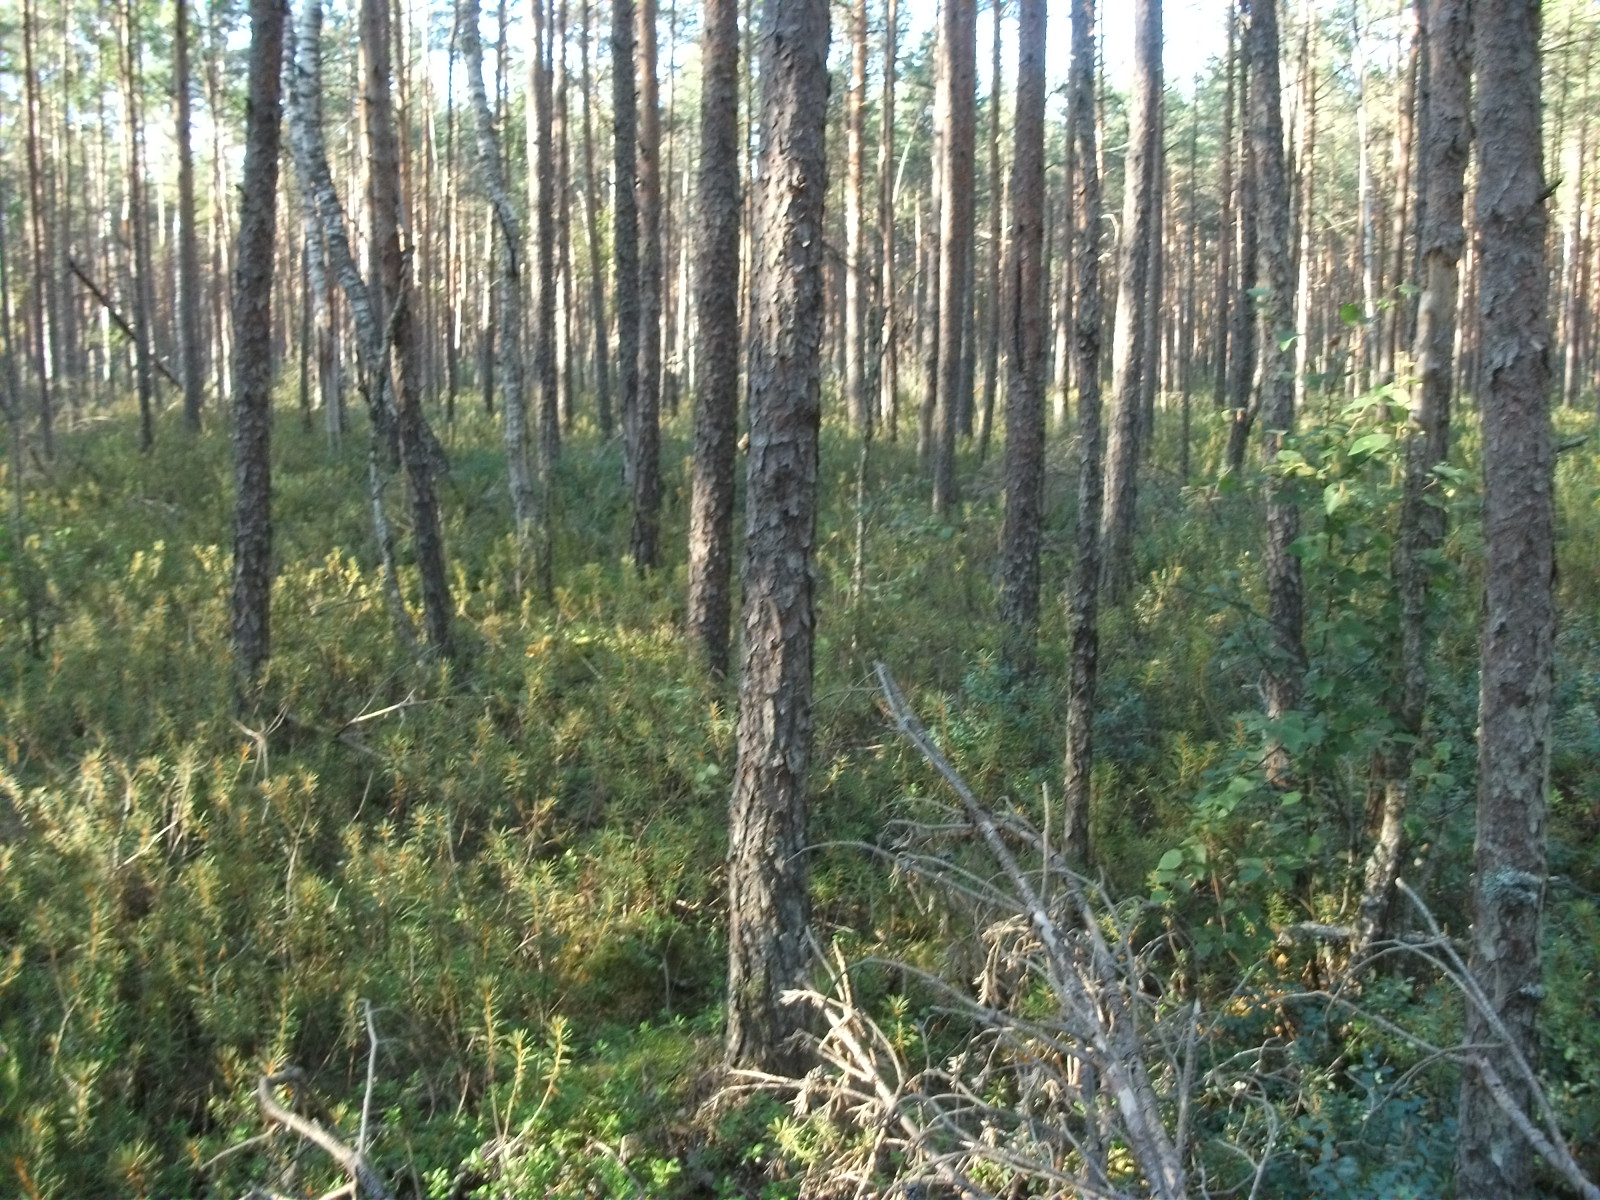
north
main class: Woodland
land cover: Pine dominated coniferous woodland
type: hemiboreal forest and nemoral coniferous forest and mixed broadleaved-coniferous forest
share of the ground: > 75 %
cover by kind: coniferous forest trees 85 %, lichens and mosses 15 %
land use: Forestry
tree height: > 5 m
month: August
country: LV
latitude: 56.5222
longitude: 26.3829
